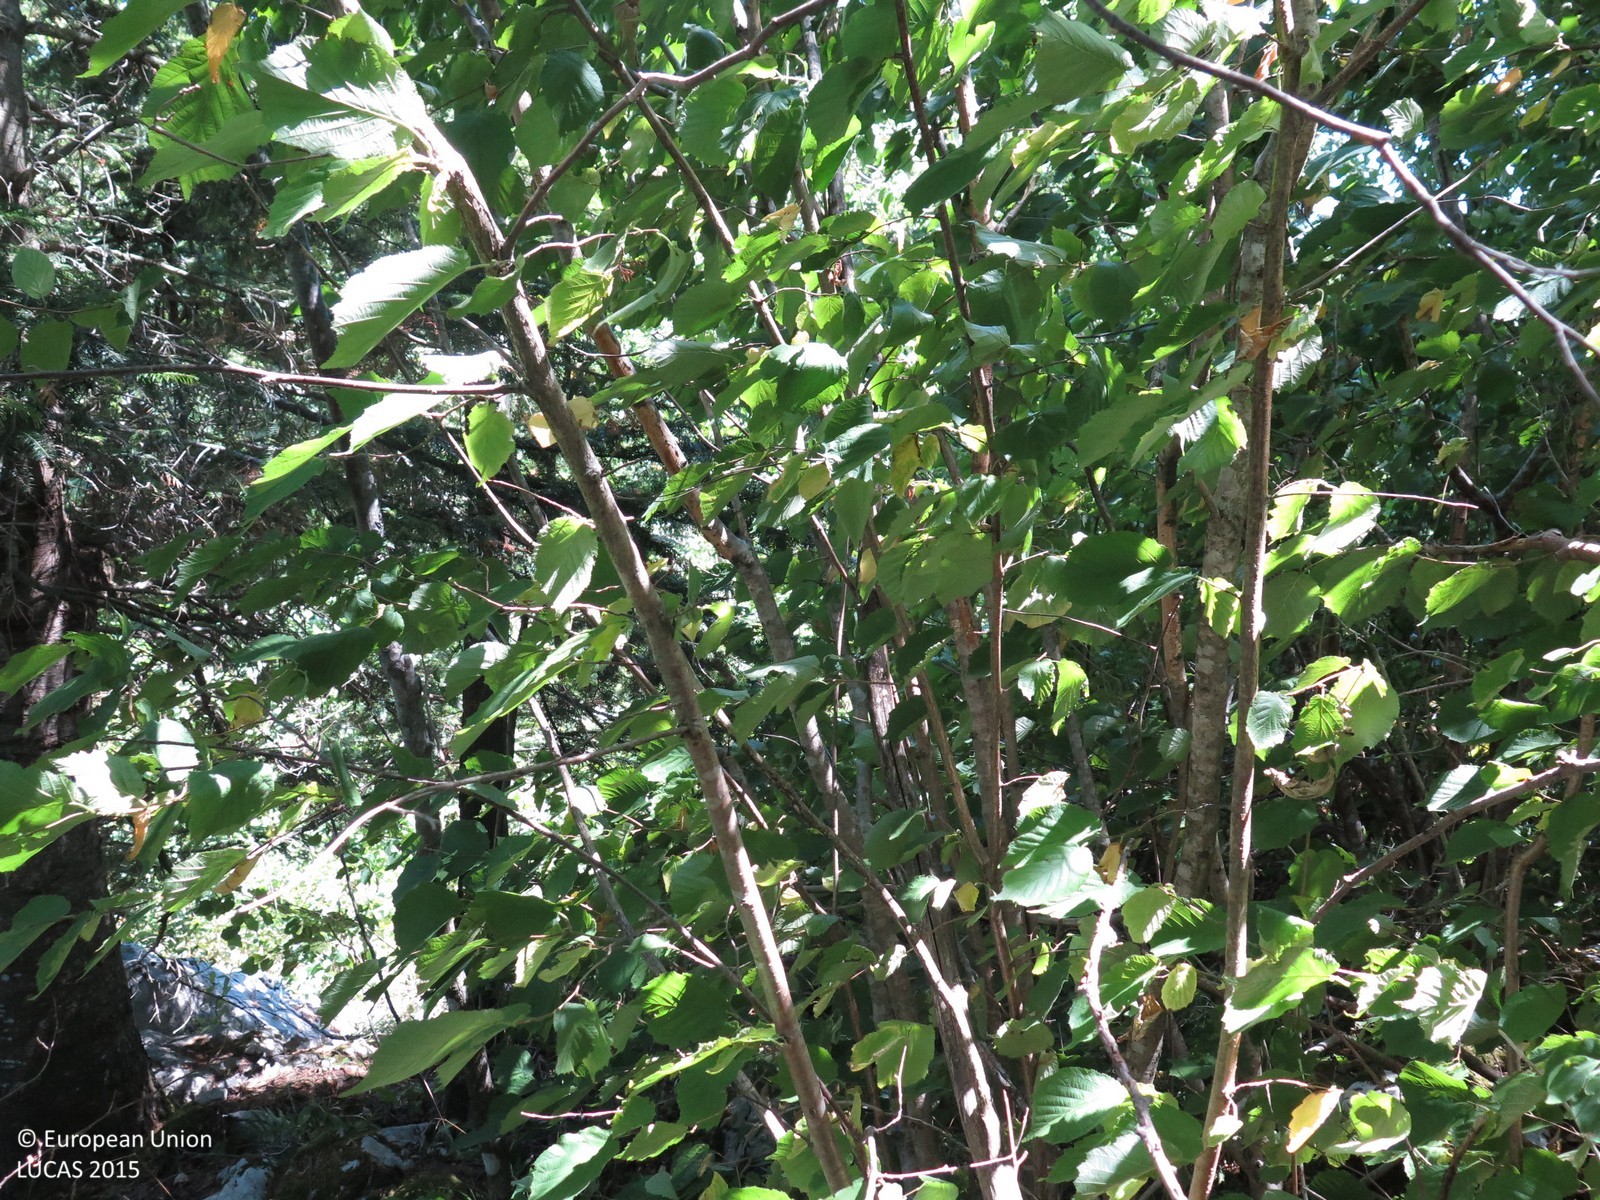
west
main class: Woodland
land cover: Other mixed woodland
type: mountainous beech forest
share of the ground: > 75 %
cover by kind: coniferous forest trees 75 %, broadleaved forest trees 25 %
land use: Forestry
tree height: > 5 m
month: August
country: HR
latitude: 45.1970
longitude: 14.7938
